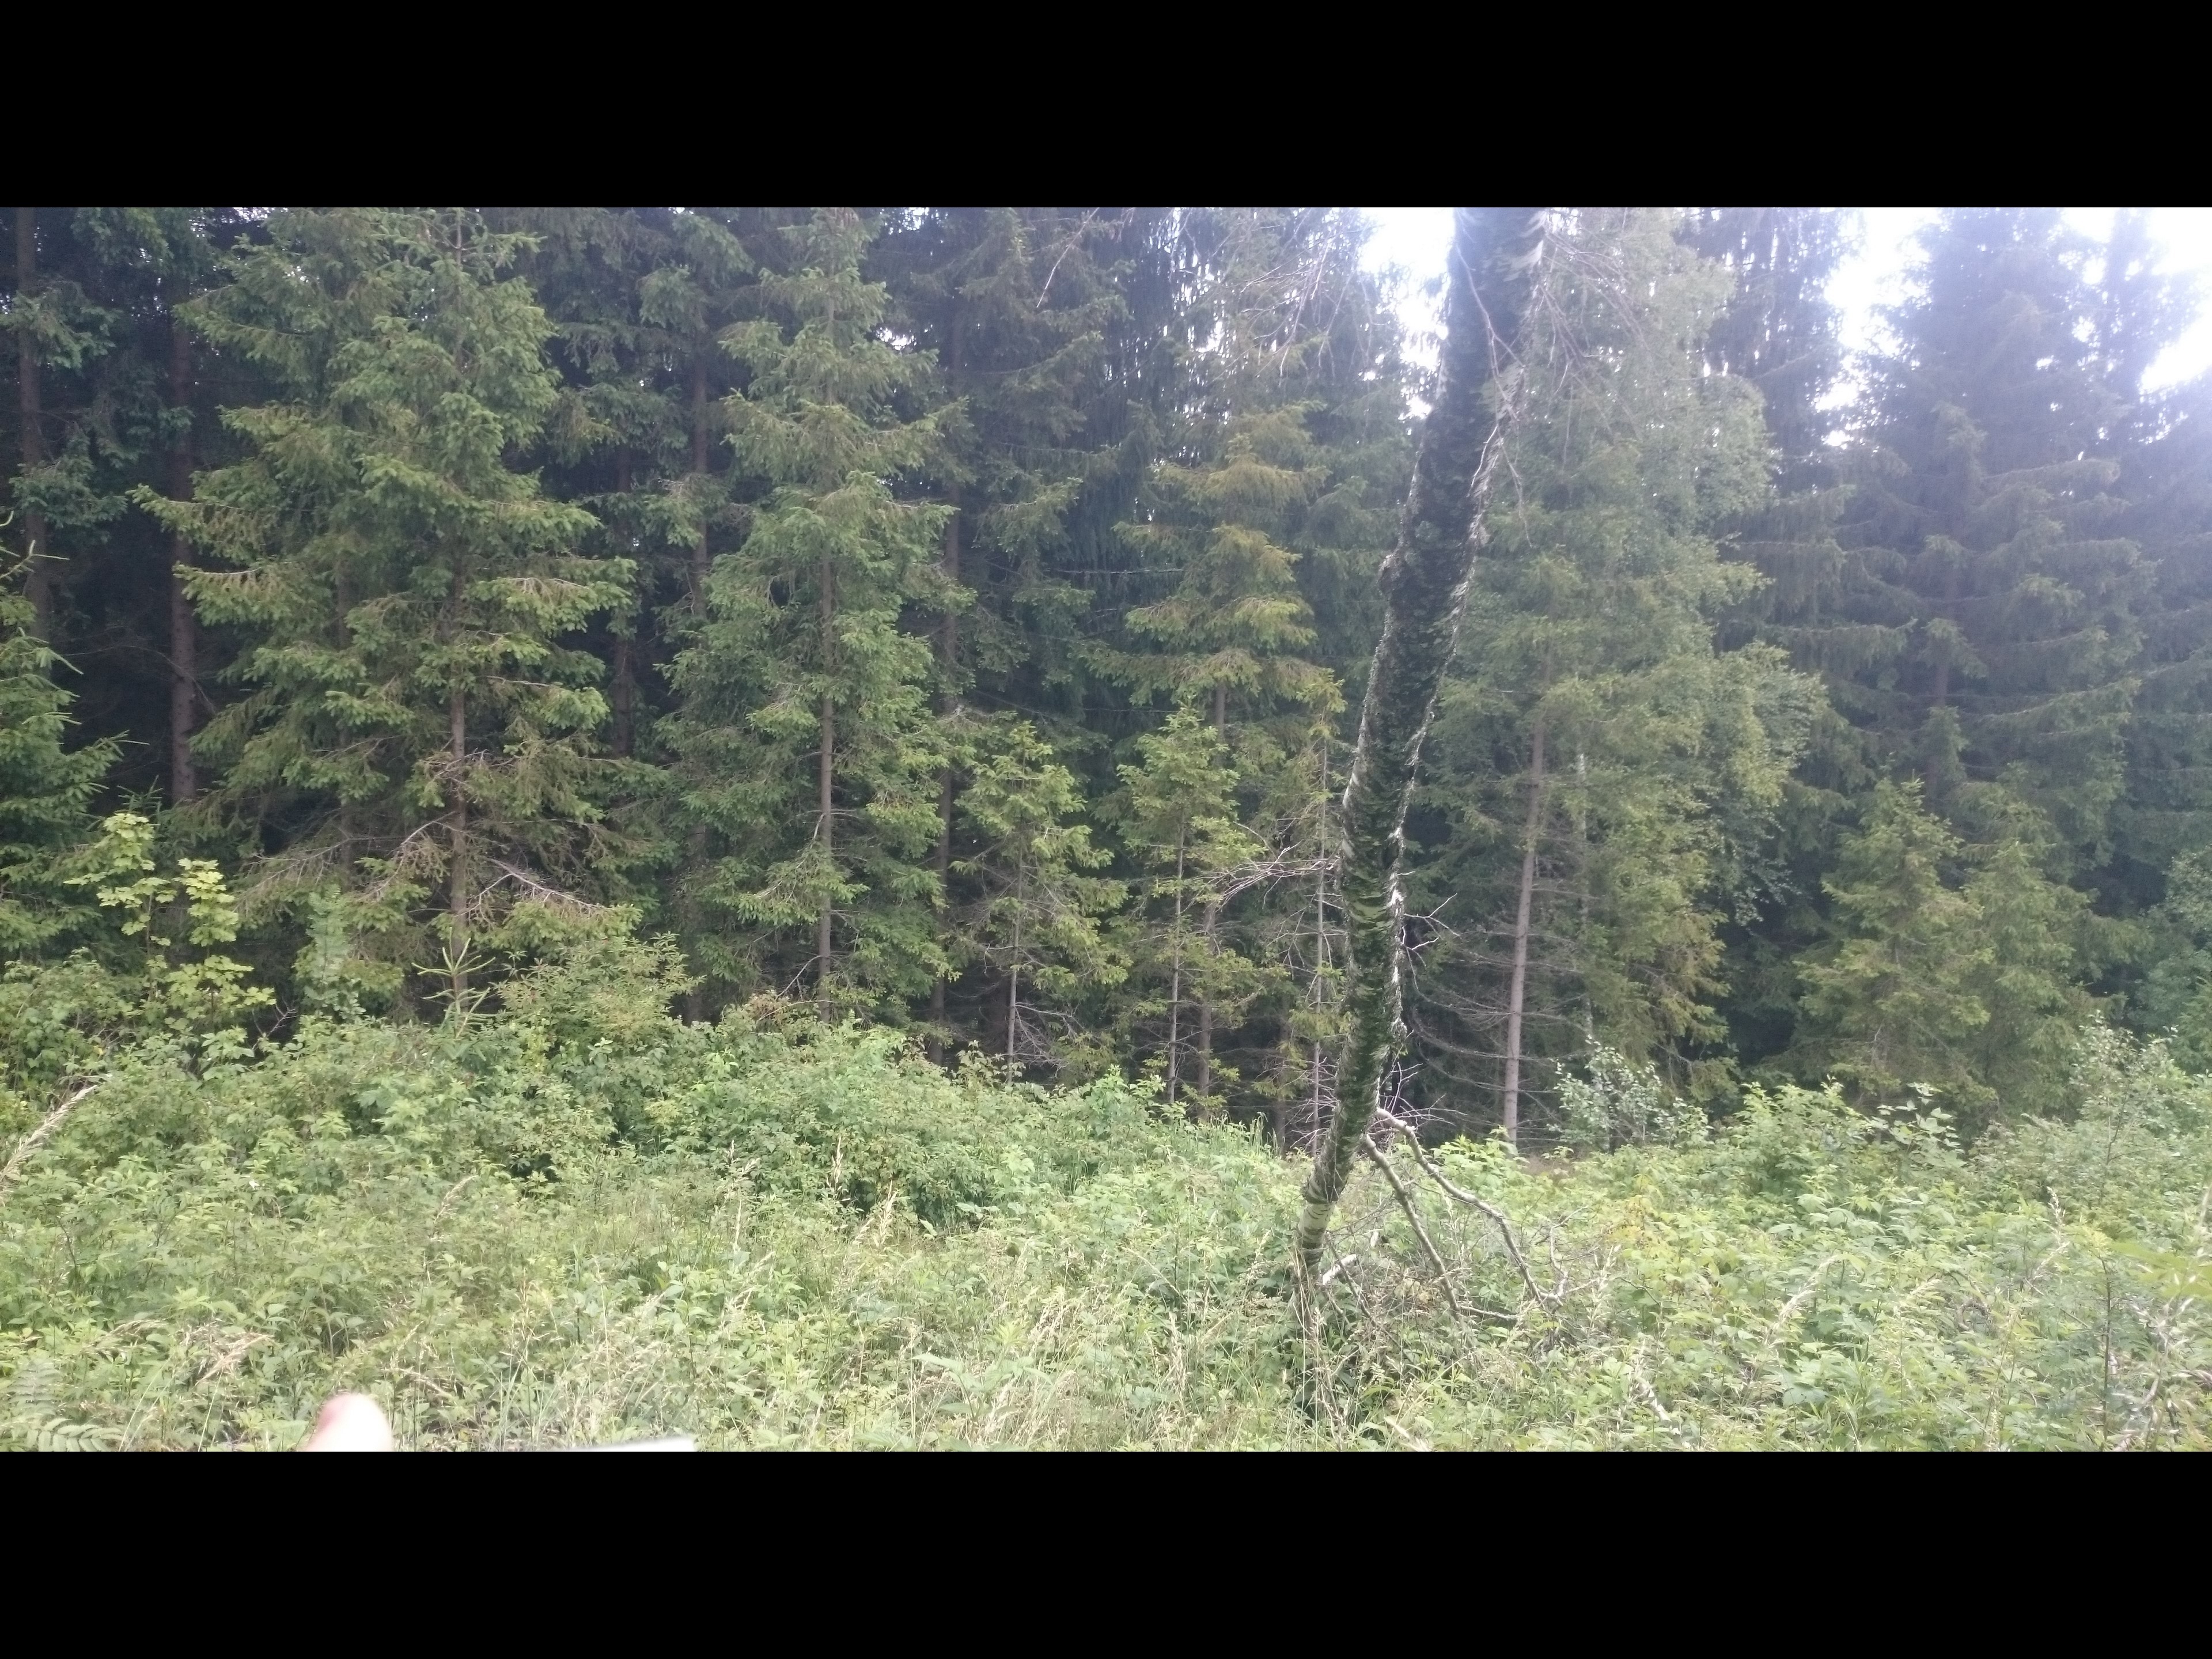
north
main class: Woodland
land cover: Broadleaved woodland
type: non-riverine alder, birch or aspen forest
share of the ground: 25 - 50 %
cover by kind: broadleaved forest trees 40 %, herbaceous plants 30 %, shrubs 25 %, coniferous forest trees 5 %
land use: Forestry
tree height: > 5 m
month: June
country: AT
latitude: 48.6230
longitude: 14.8175
